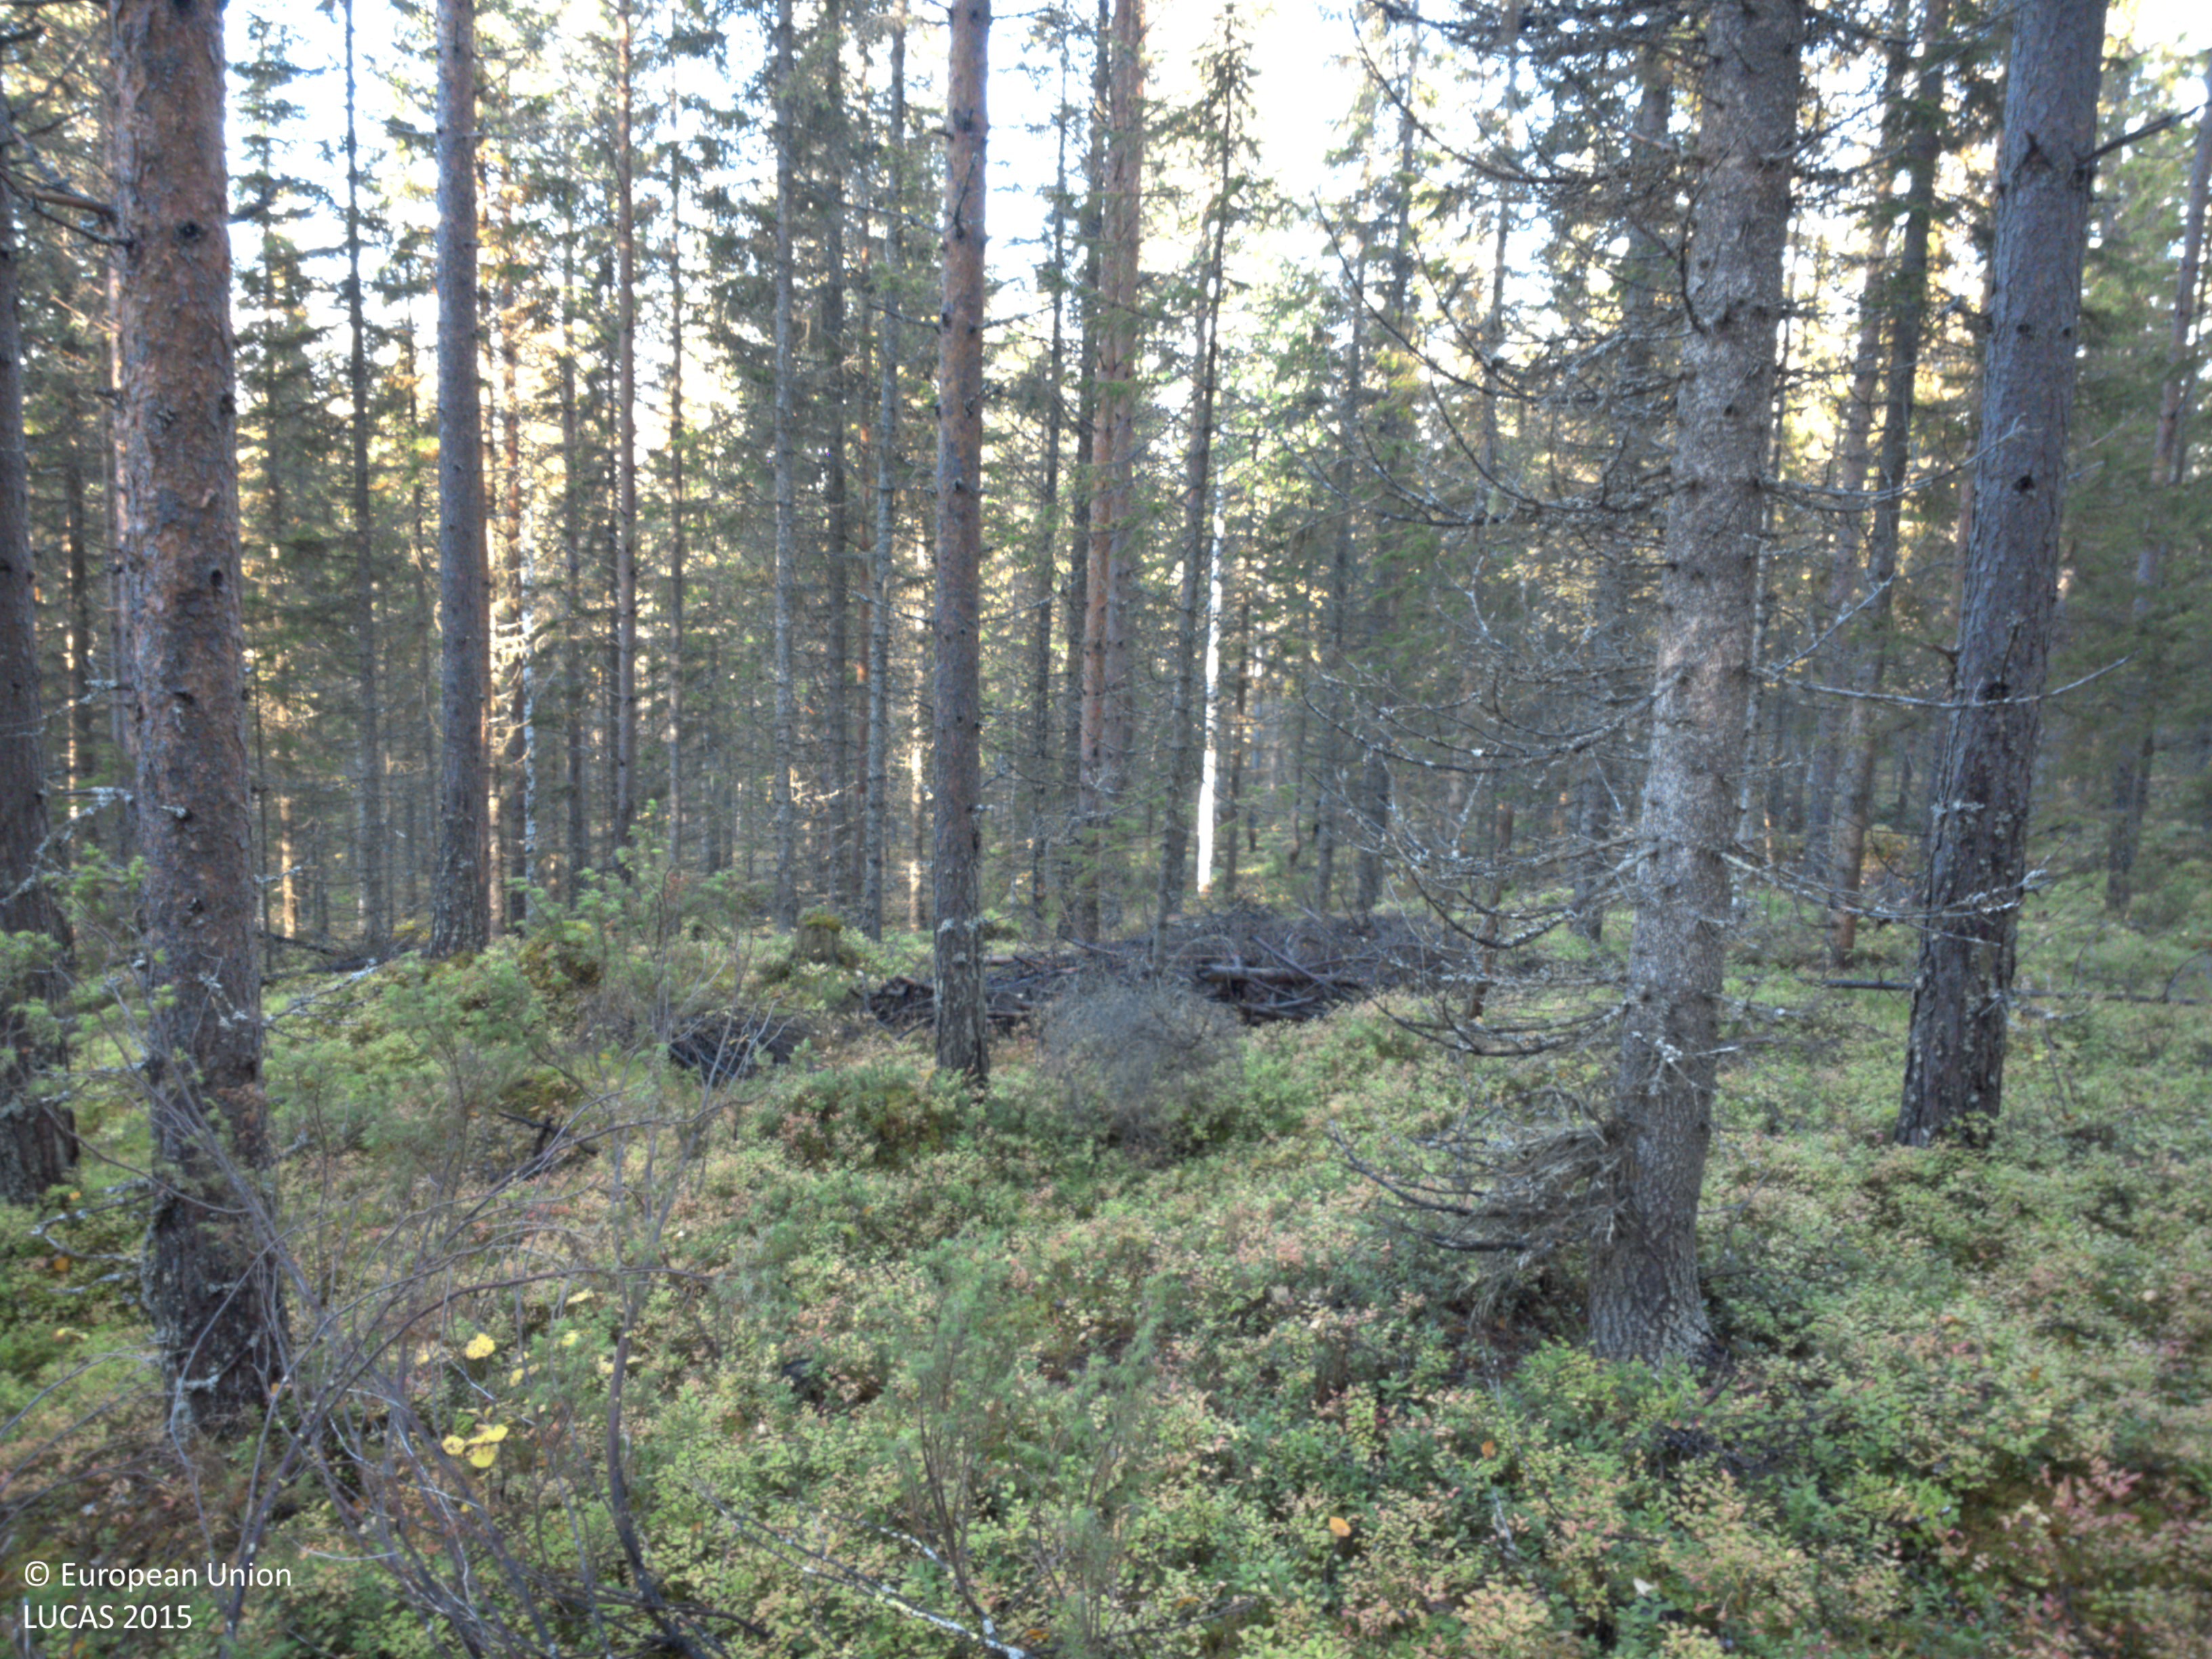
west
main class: Woodland
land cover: Other coniferous woodland
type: boreal forest
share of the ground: > 75 %
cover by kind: coniferous forest trees 75 %, shrubs 15 %, lichens and mosses 10 %
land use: Forestry
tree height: > 5 m
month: September
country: SE
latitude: 64.8358
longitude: 18.9668
